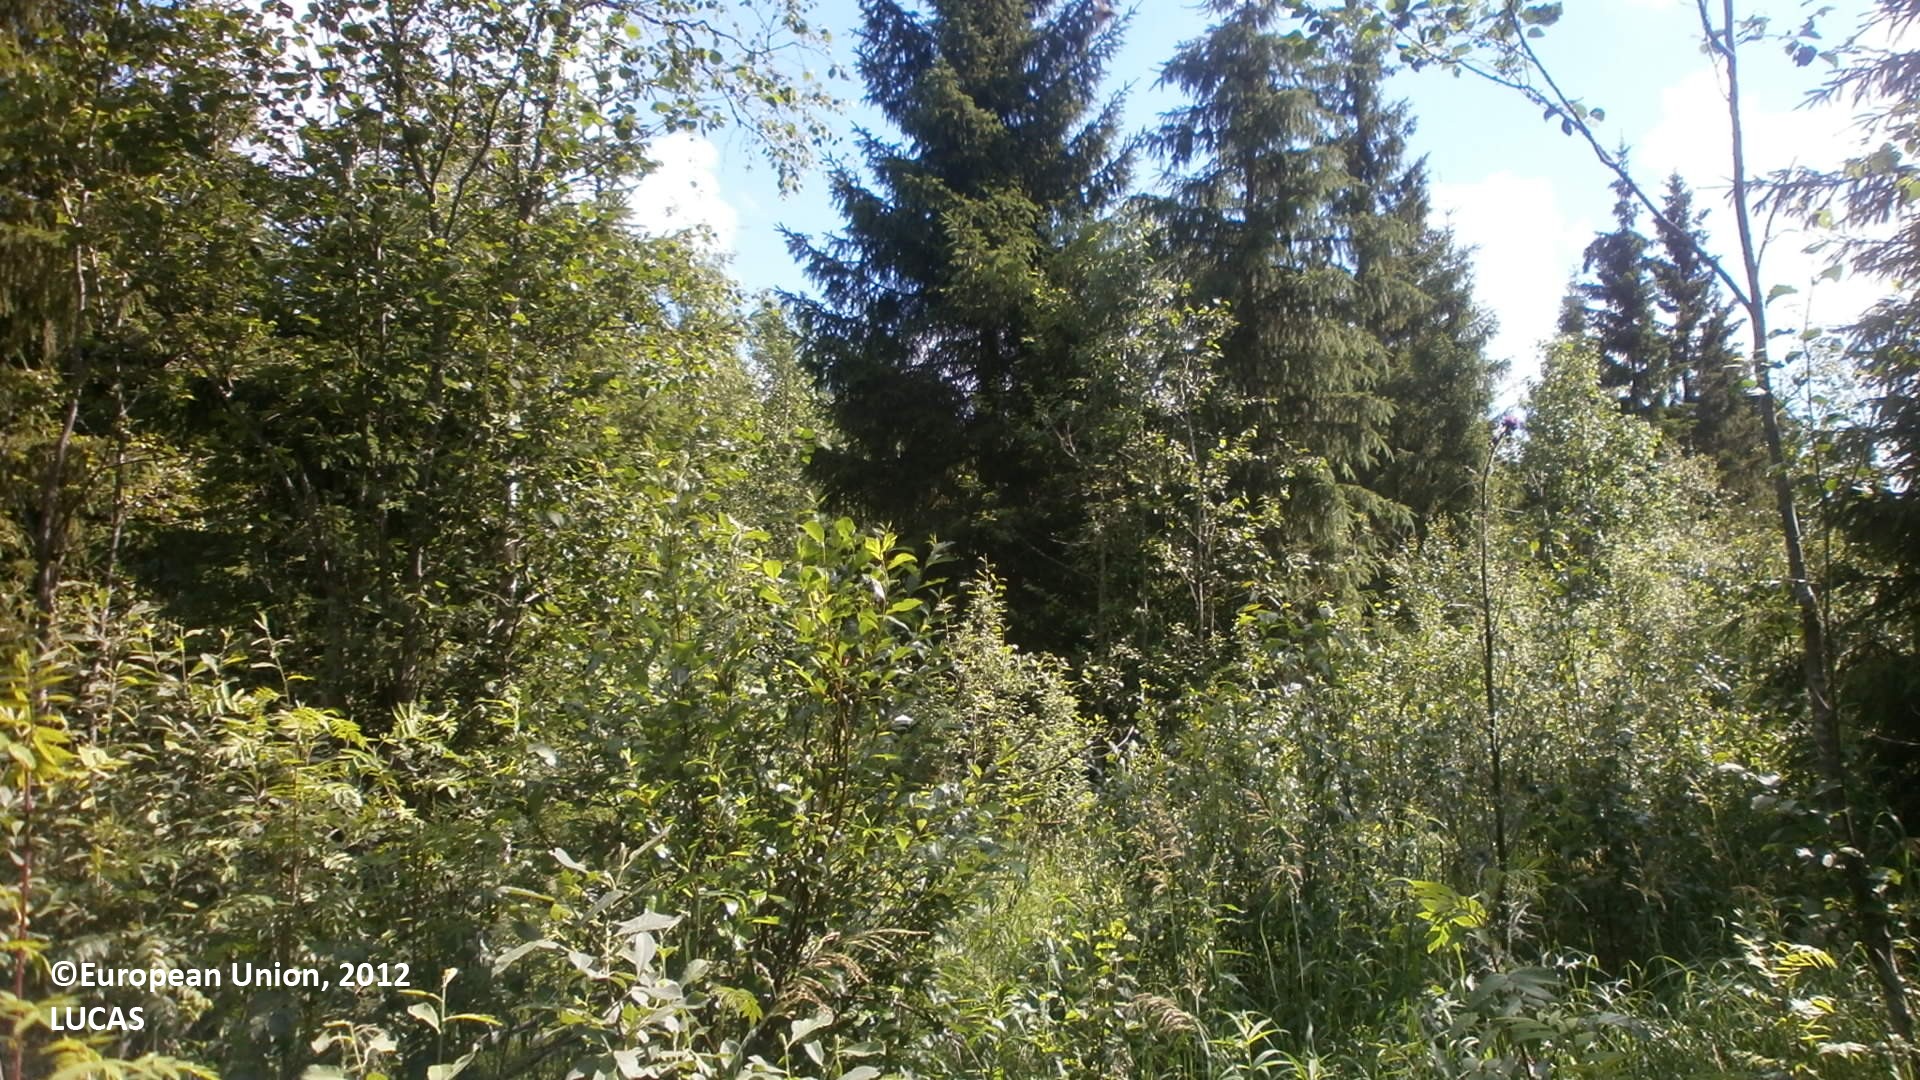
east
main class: Woodland
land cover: Spruce dominated mixed woodland
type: boreal forest
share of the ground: 50 - 75 %
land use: Forestry
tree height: > 5 m
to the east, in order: Spruce dominated mixed woodland; Ditches and canals; Spruce dominated mixed woodland; Ditches and canals; Broadleaved woodland; Spruce dominated mixed woodland; Ditches and canals; Spruce dominated mixed woodland; Pine dominated coniferous woodland; Pine dominated mixed woodland; Ditches and canals; Pine dominated coniferous woodland
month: July
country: FI
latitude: 64.4277
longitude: 24.5007
